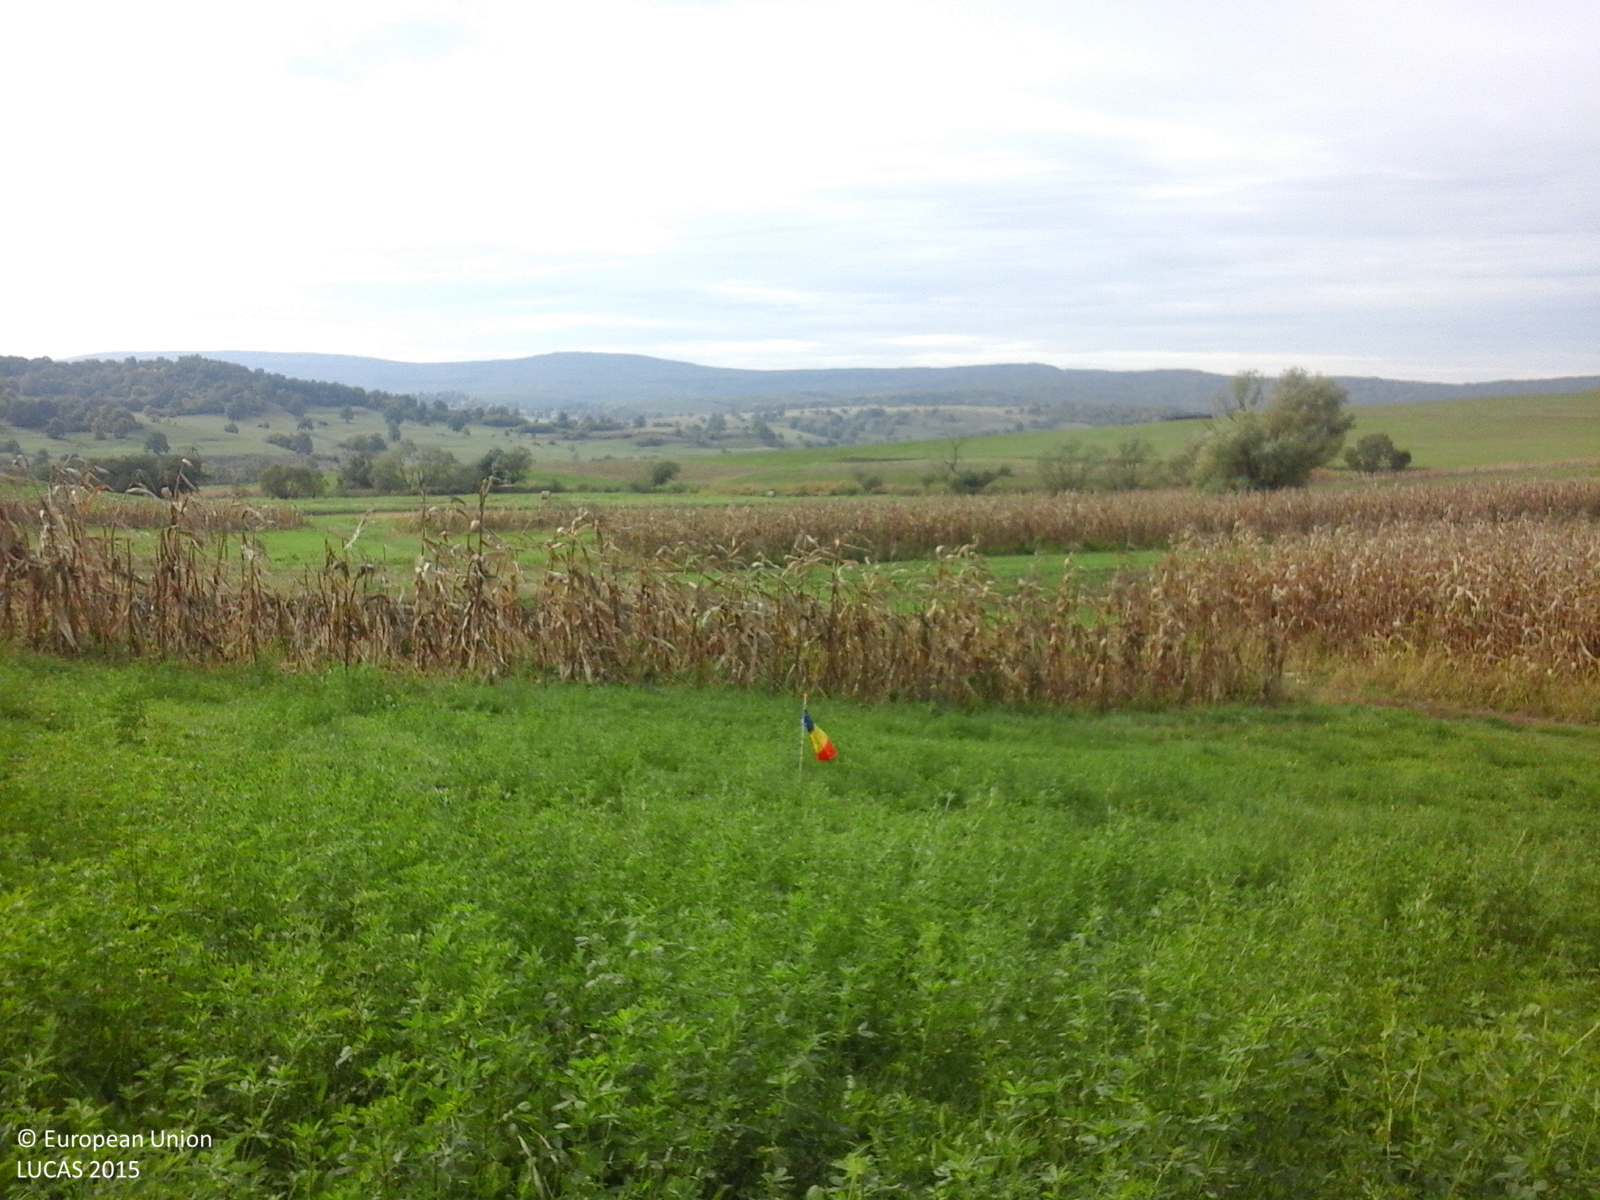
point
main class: Cropland
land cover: Lucerne
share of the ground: > 75 %
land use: Agriculture (excluding fallow land and kitchen gardens)
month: October
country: RO
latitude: 46.1991
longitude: 25.1438
